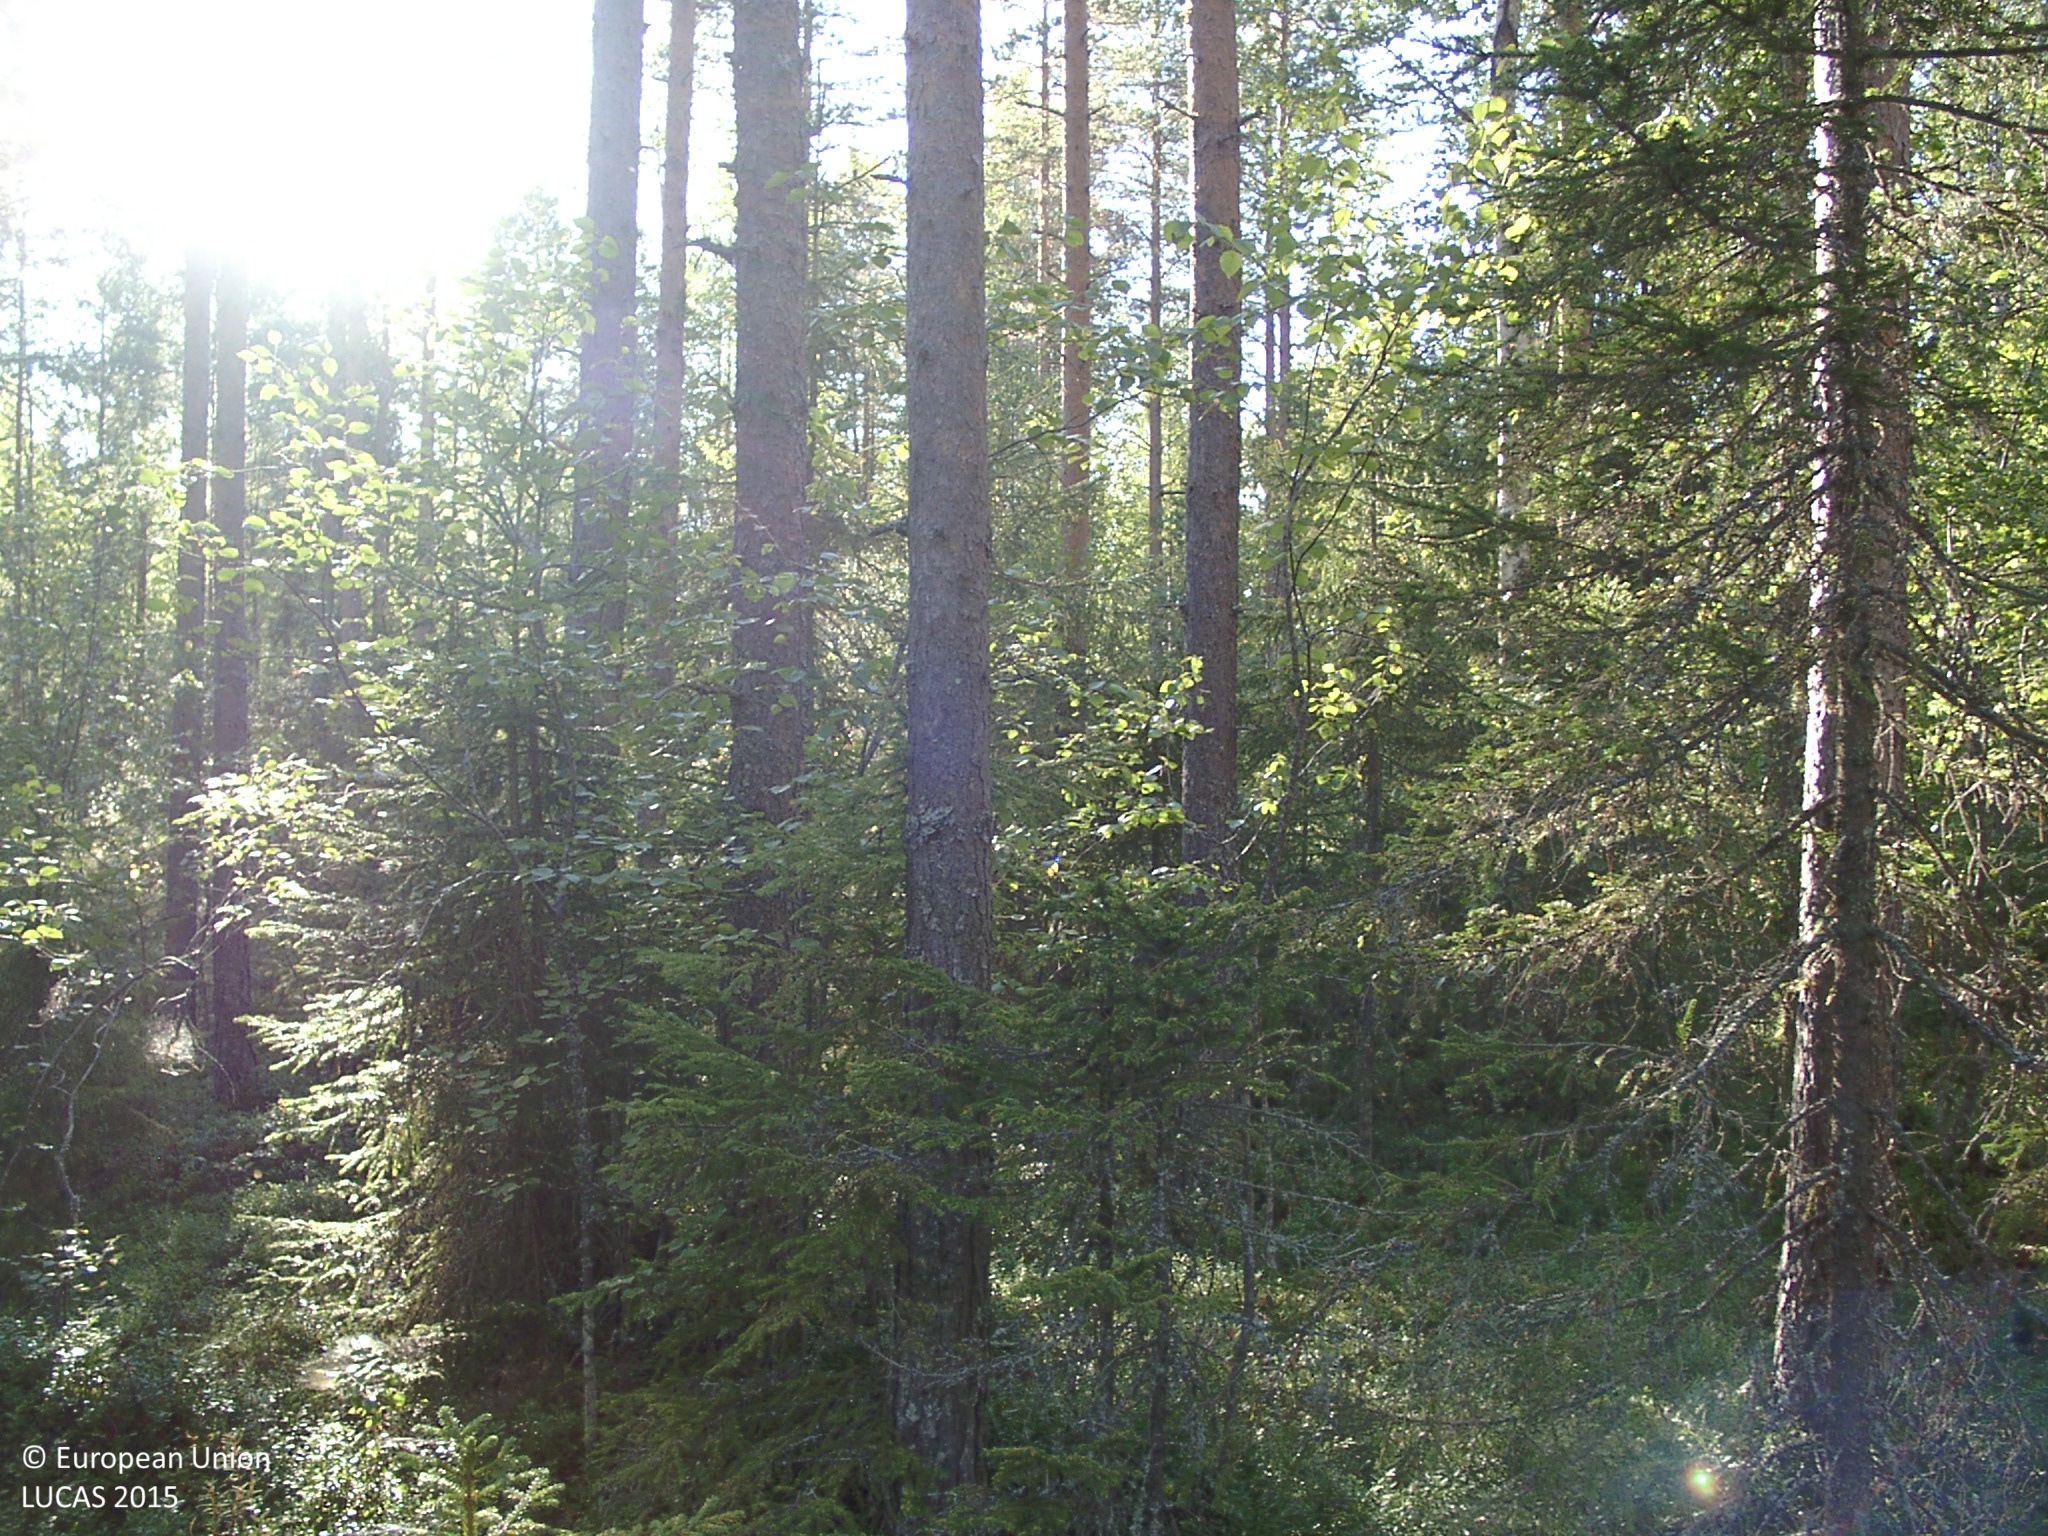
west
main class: Woodland
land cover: Other mixed woodland
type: boreal forest
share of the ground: 50 - 75 %
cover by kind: coniferous forest trees 50 %, shrubs 25 %, broadleaved forest trees 20 %, lichens and mosses 5 %
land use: Forestry
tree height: > 5 m
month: August
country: FI
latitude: 62.4286
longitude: 25.1520
